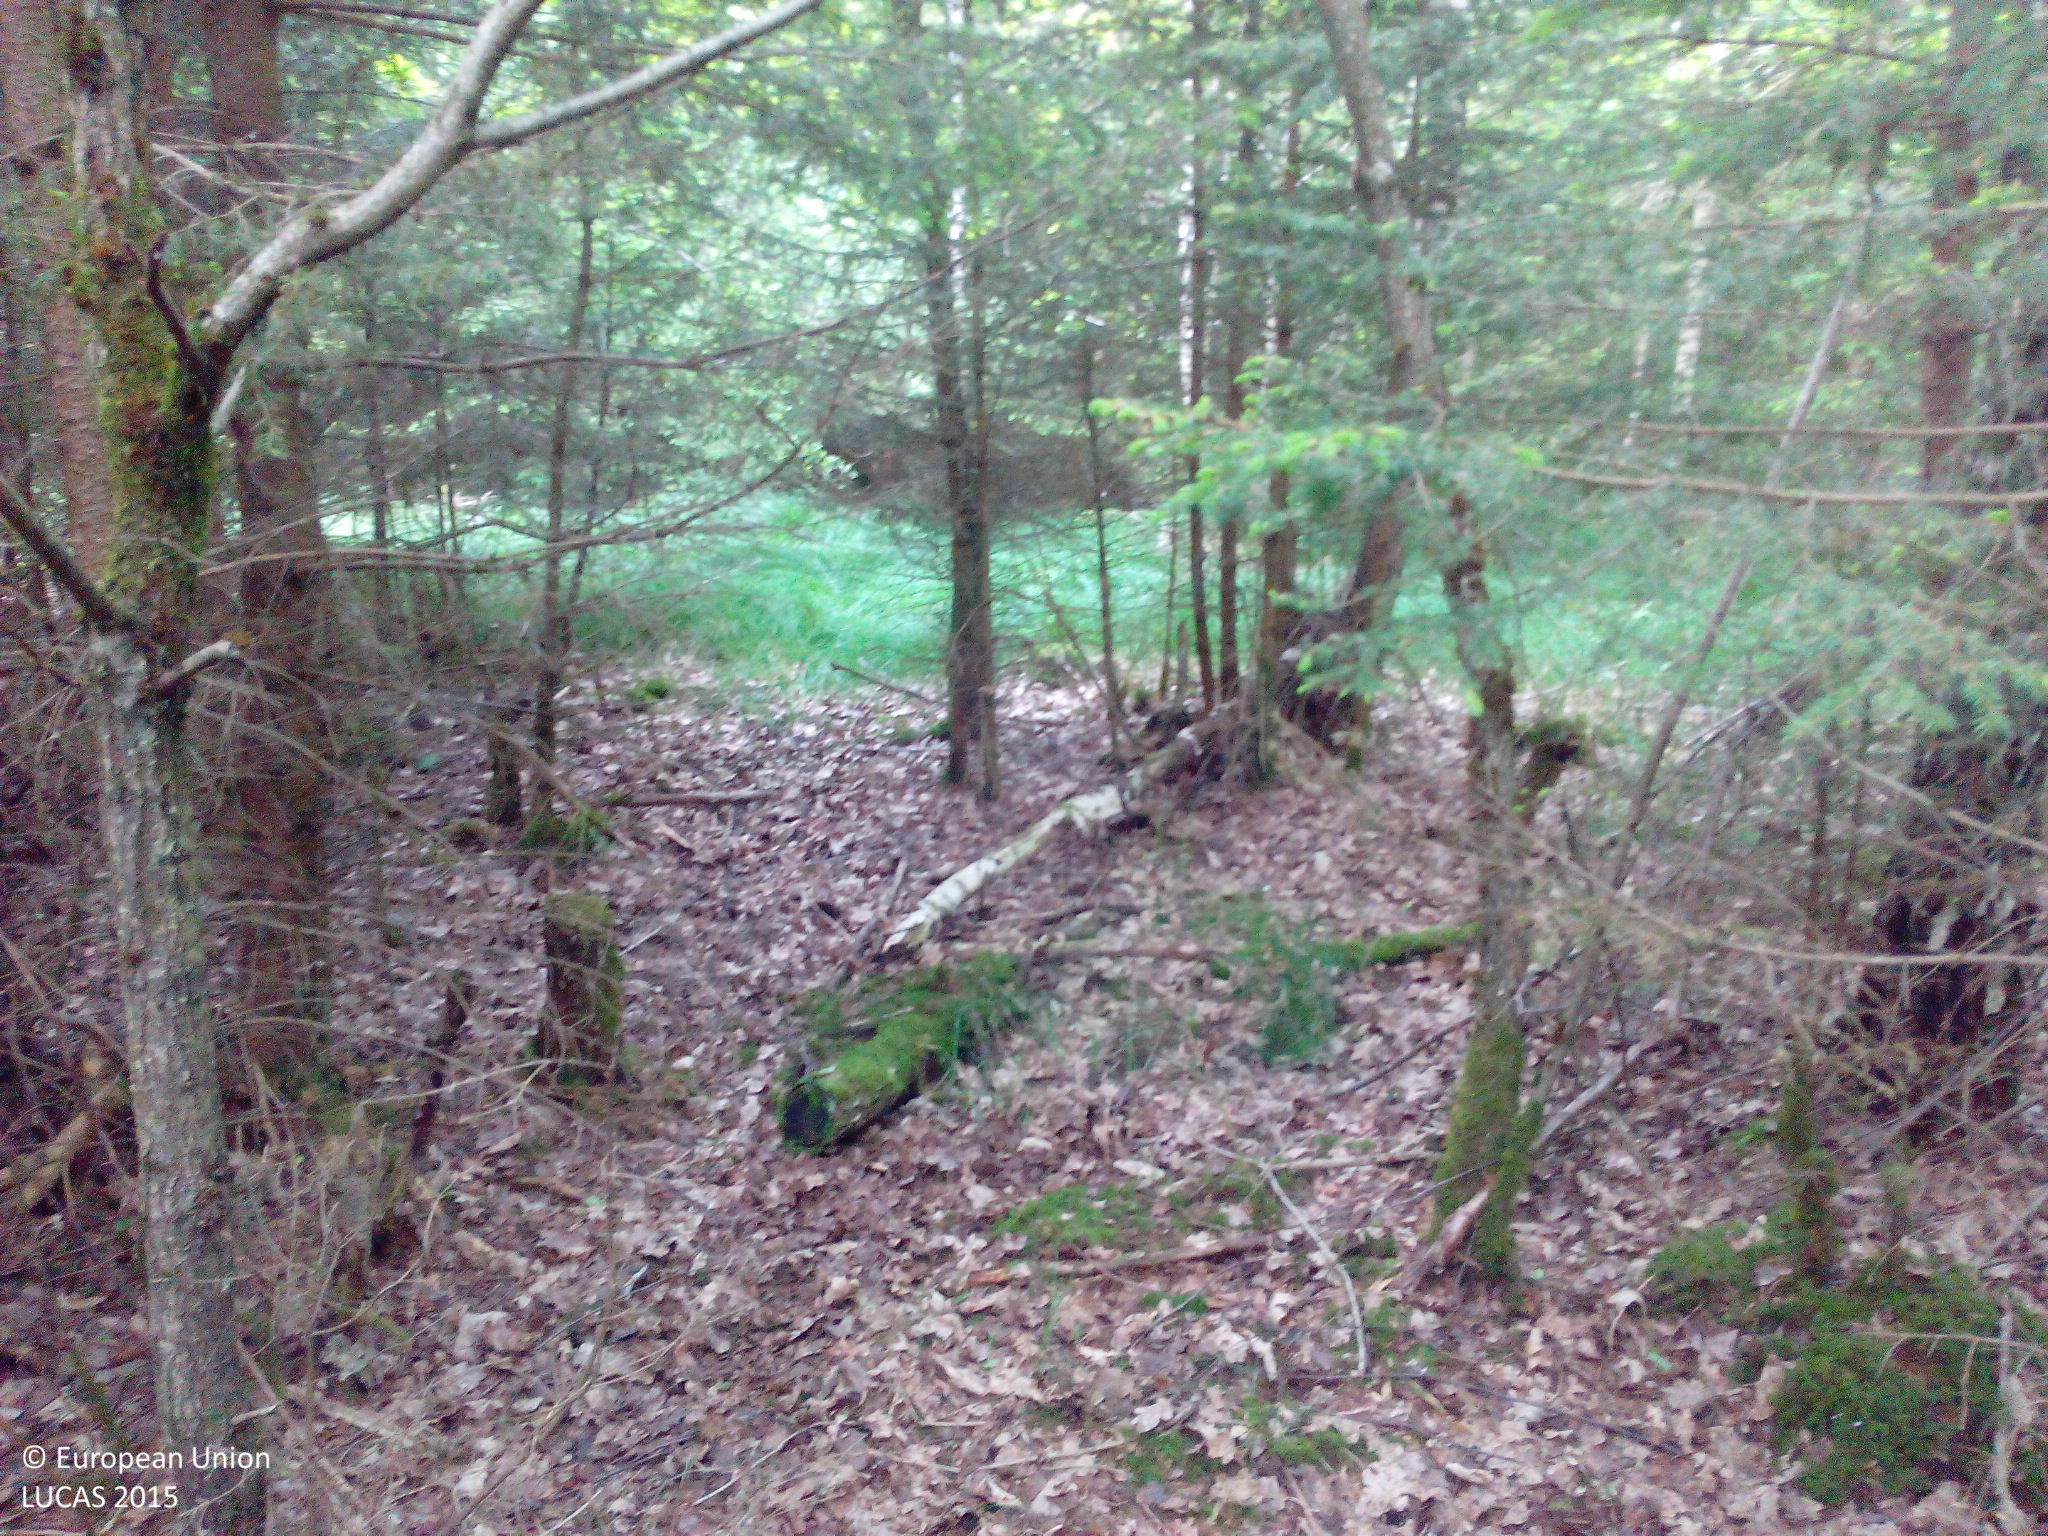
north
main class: Woodland
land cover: Spruce dominated mixed woodland
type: hemiboreal forest and nemoral coniferous forest and mixed broadleaved-coniferous forest
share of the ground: > 75 %
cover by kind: coniferous forest trees 70 %, broadleaved forest trees 30 %
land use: Forestry
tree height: > 5 m
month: May
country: DE
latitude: 48.2232
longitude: 10.2556
